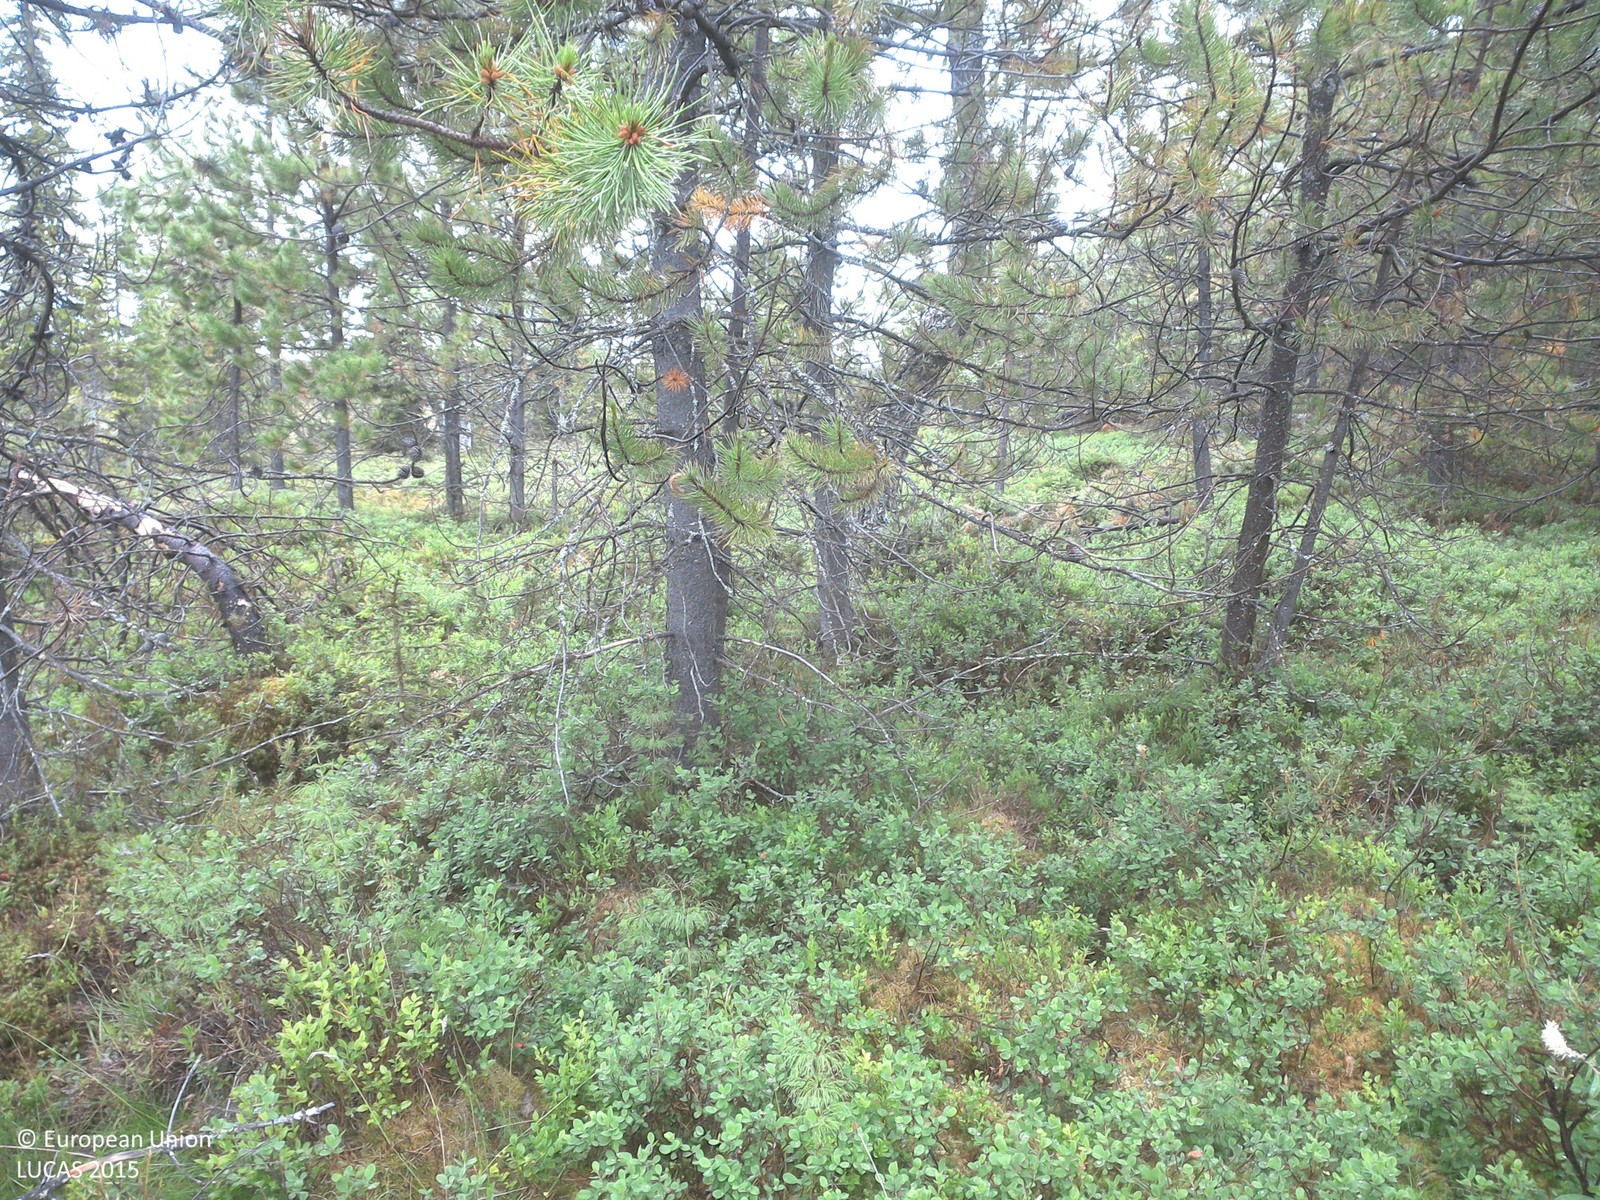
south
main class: Woodland
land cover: Pine dominated coniferous woodland
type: exotic forest
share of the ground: 25 - 50 %
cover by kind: shrubs 70 %, coniferous forest trees 25 %, lichens and mosses 5 %
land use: Forestry
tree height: > 5 m
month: July
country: SE
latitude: 67.5798
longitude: 23.1920
